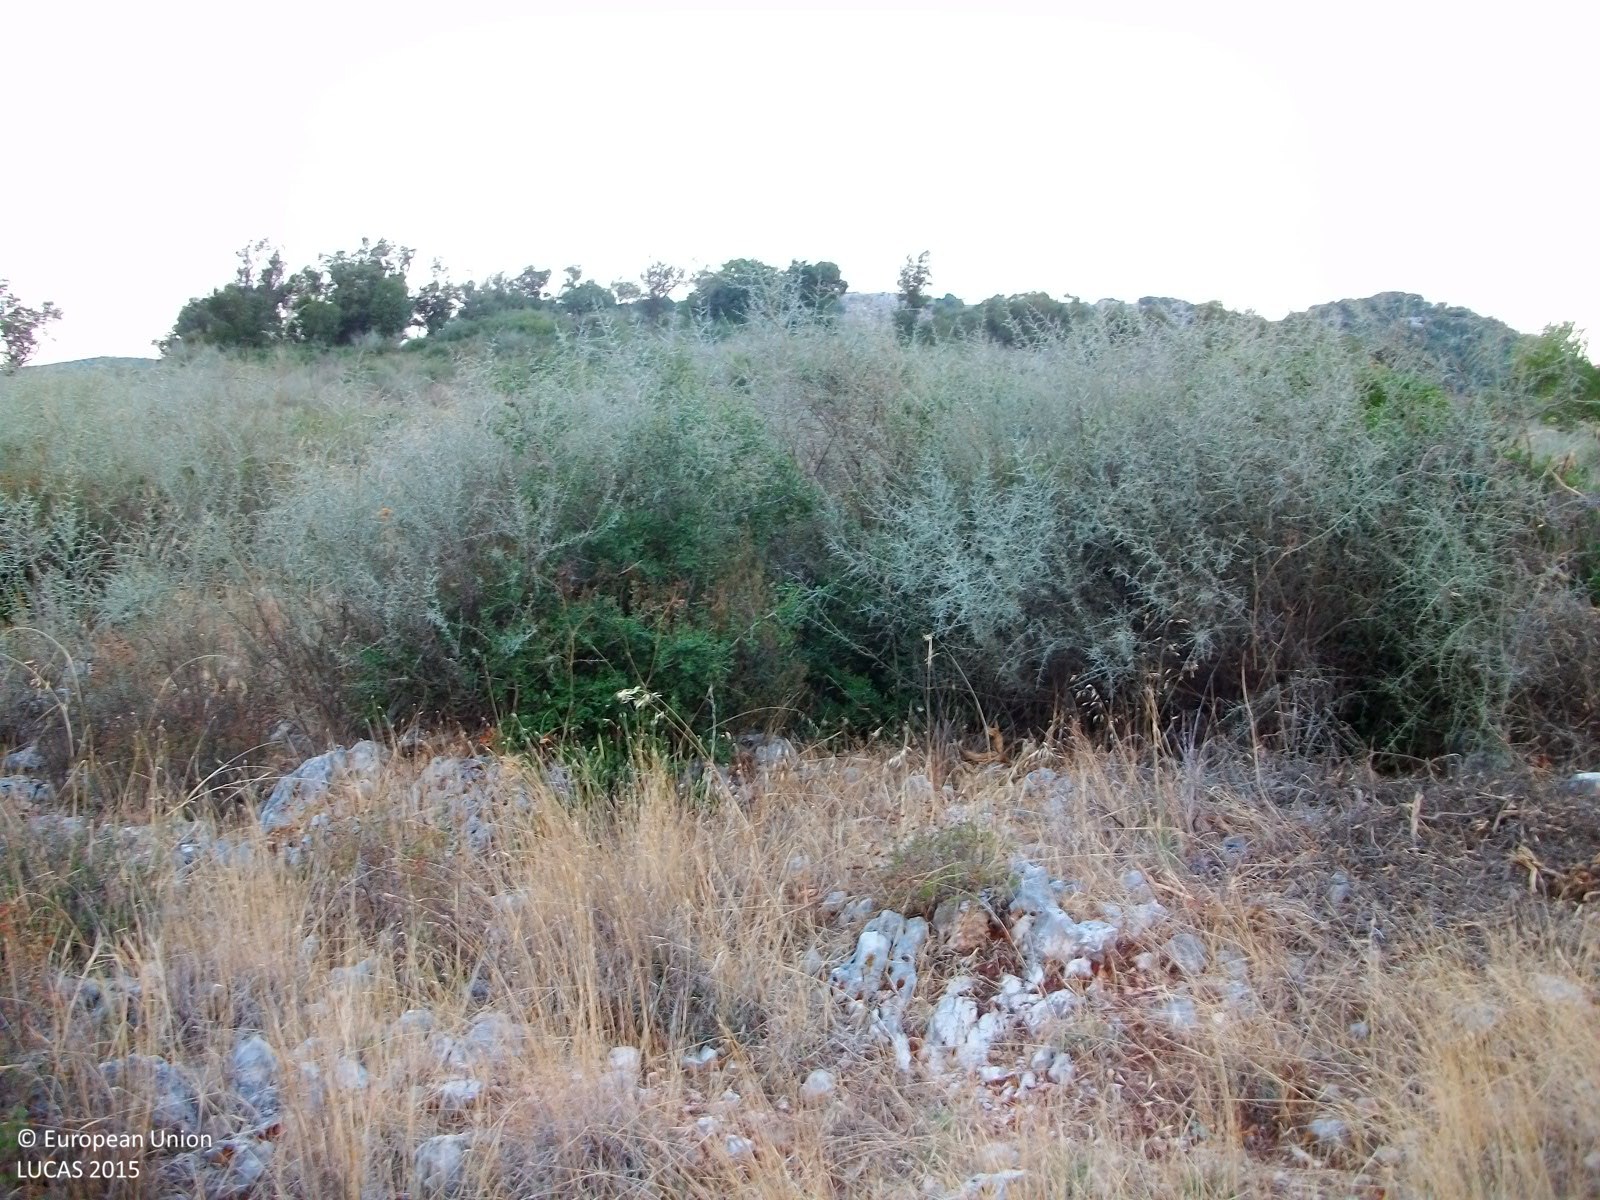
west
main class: Shrubland
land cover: Shrubland with sparse tree cover
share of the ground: > 75 %
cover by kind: shrubs 95 %, broadleaved forest trees 5 %
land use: Semi-natural and natural areas not in use
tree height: < 5 m
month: August
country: GR
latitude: 37.8910
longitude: 20.7040
